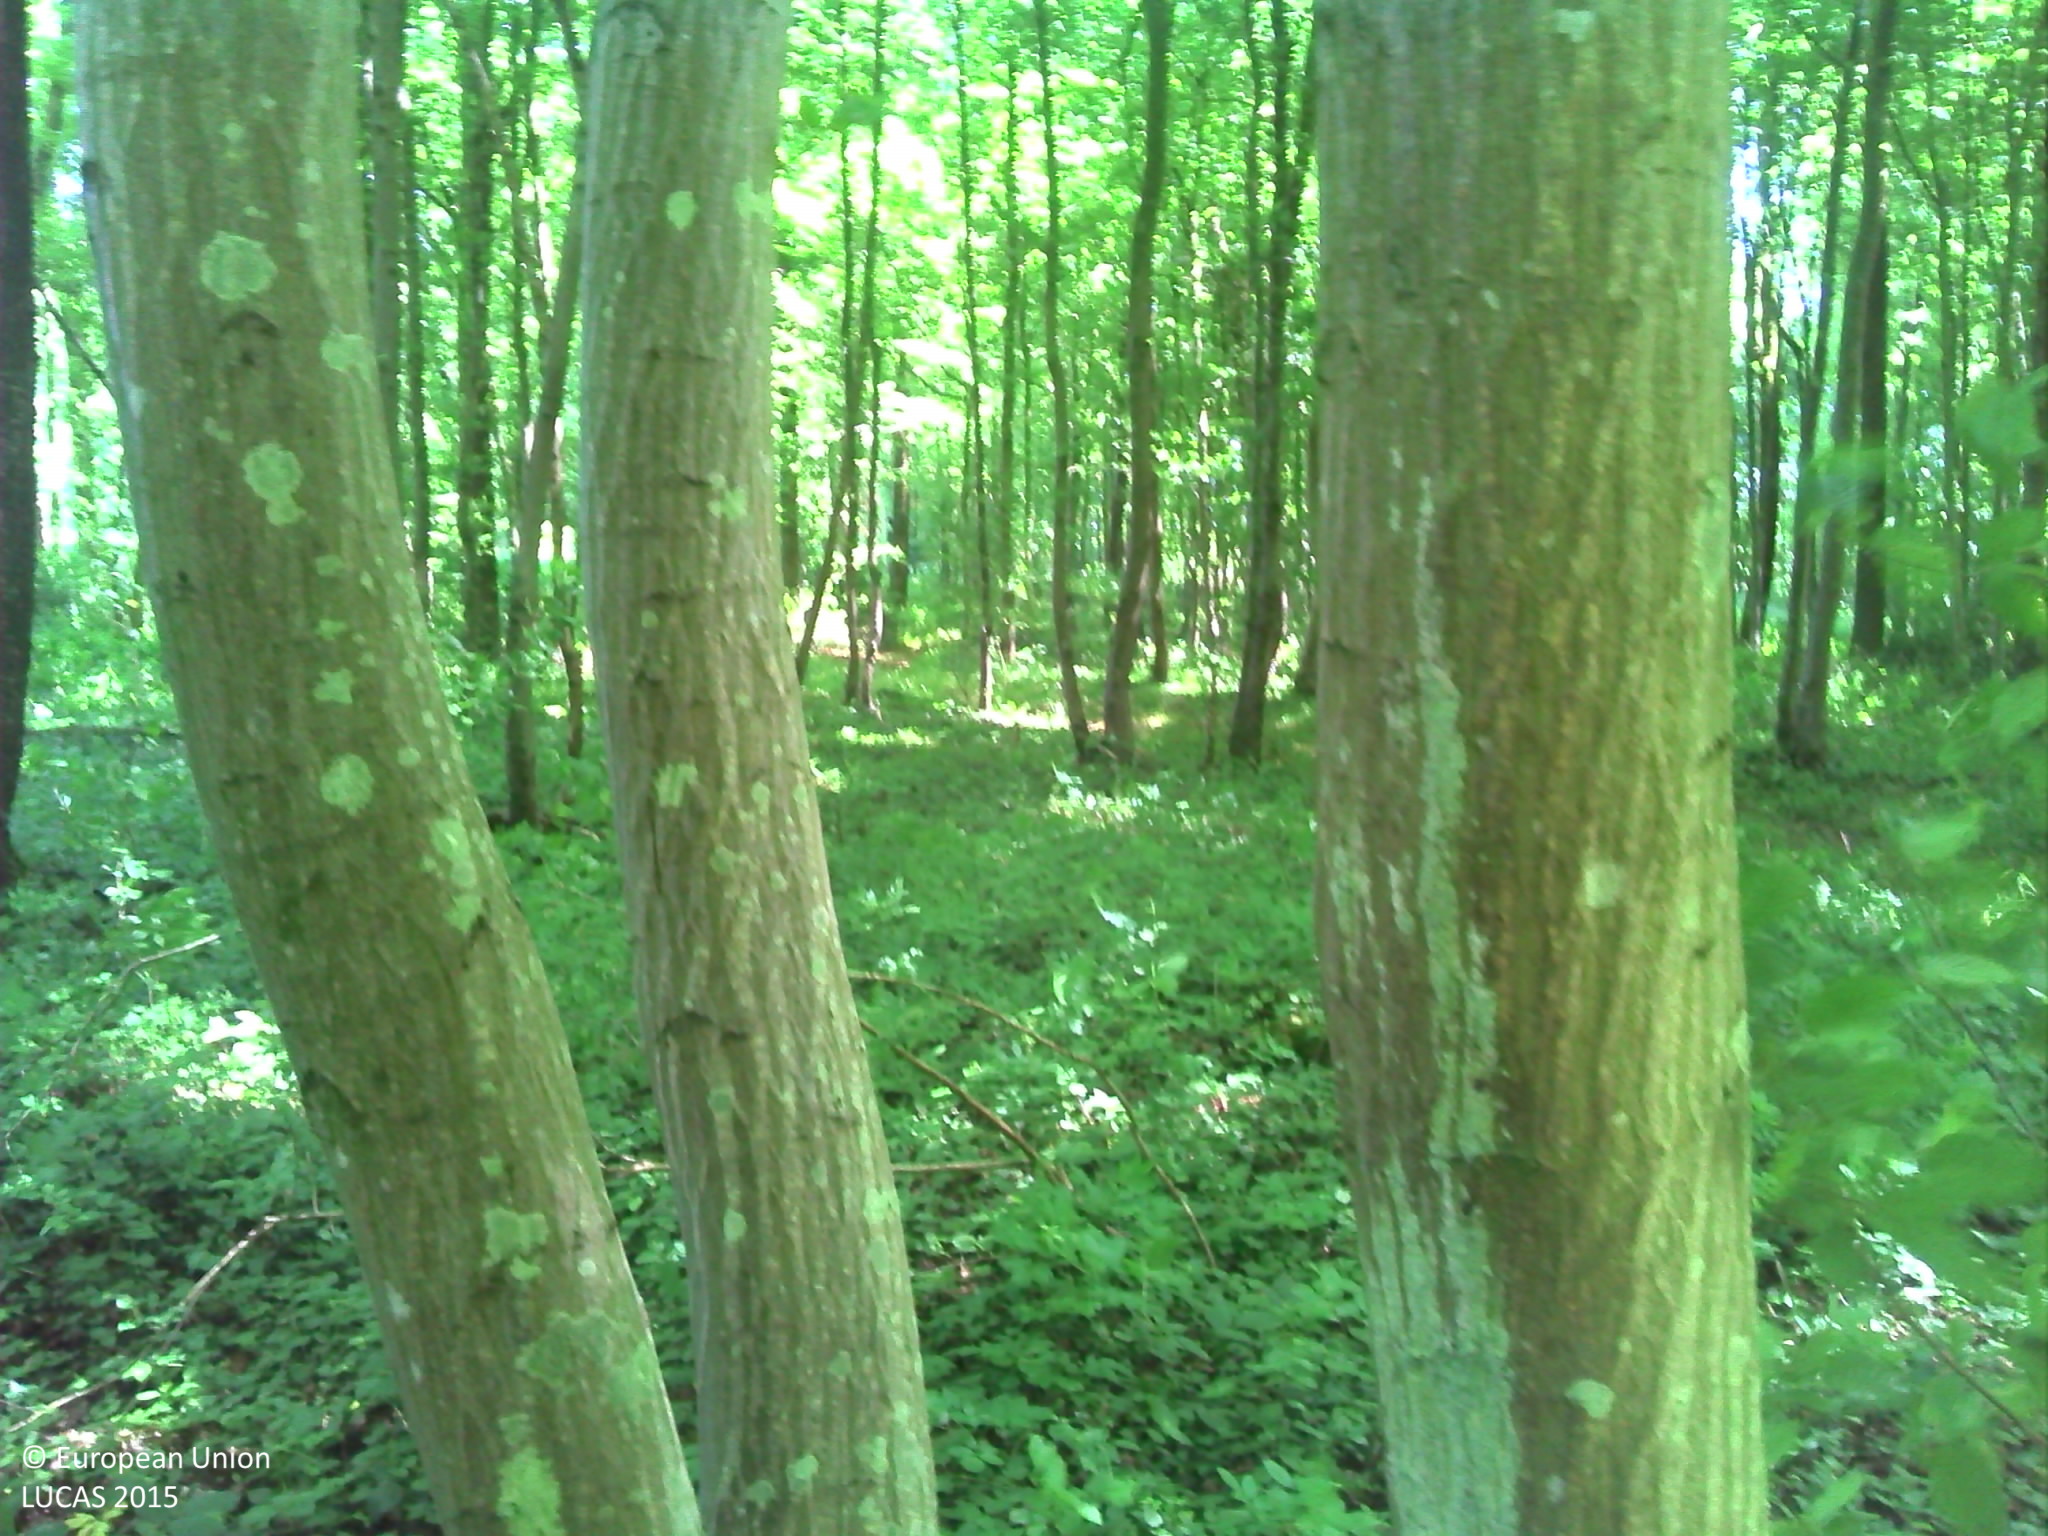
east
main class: Woodland
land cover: Broadleaved woodland
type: mesophytic deciduous forest
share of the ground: > 75 %
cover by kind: broadleaved forest trees 80 %, shrubs 10 %, herbaceous plants 10 %
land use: Forestry
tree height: > 5 m
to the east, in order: Broadleaved woodland; Grass margins; Paved roads, cycling and walking lanes; Grass margins; Broadleaved woodland; Spruce dominated coniferous woodland; Broadleaved woodland; Fences; Grassland without tree/shrub cover; Fences; Broadleaved woodland
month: June
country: FR
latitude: 49.9084
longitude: 4.1606
